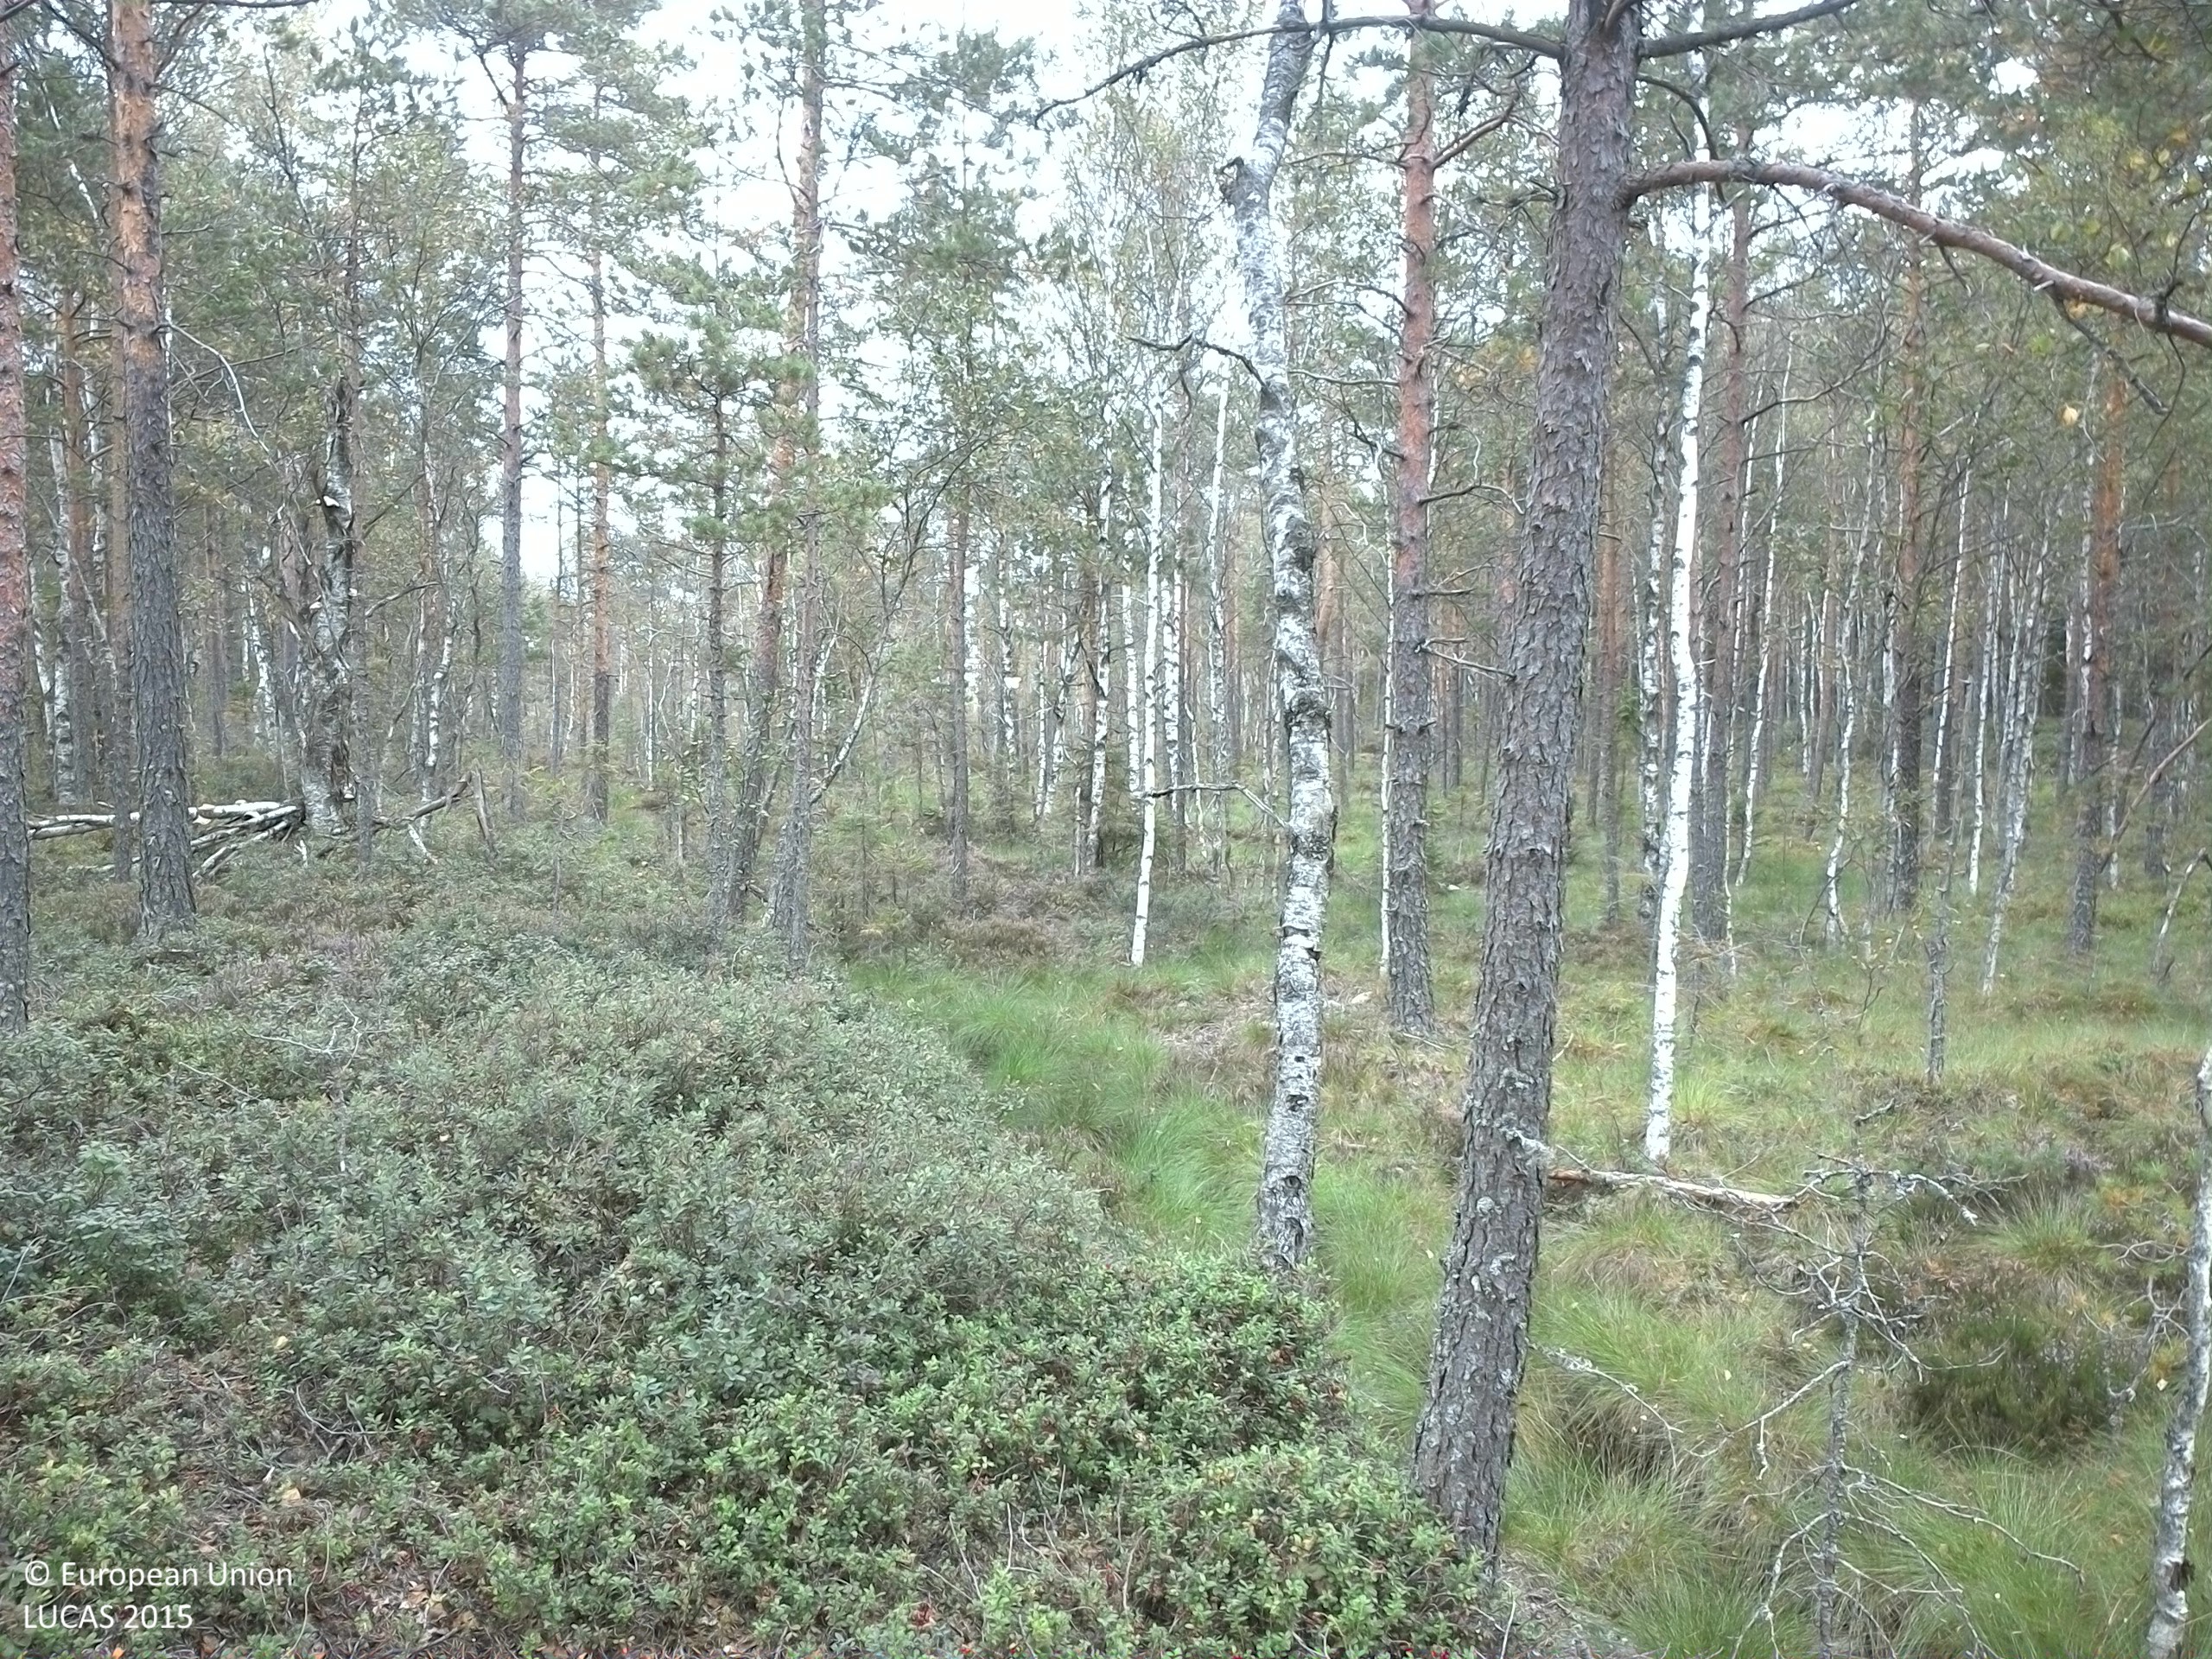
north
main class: Woodland
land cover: Pine dominated mixed woodland
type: boreal forest
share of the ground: 50 - 75 %
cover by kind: coniferous forest trees 40 %, broadleaved forest trees 25 %, shrubs 25 %, lichens and mosses 10 %
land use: Forestry
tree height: > 5 m
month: September
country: SE
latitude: 59.7983
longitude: 13.3598
